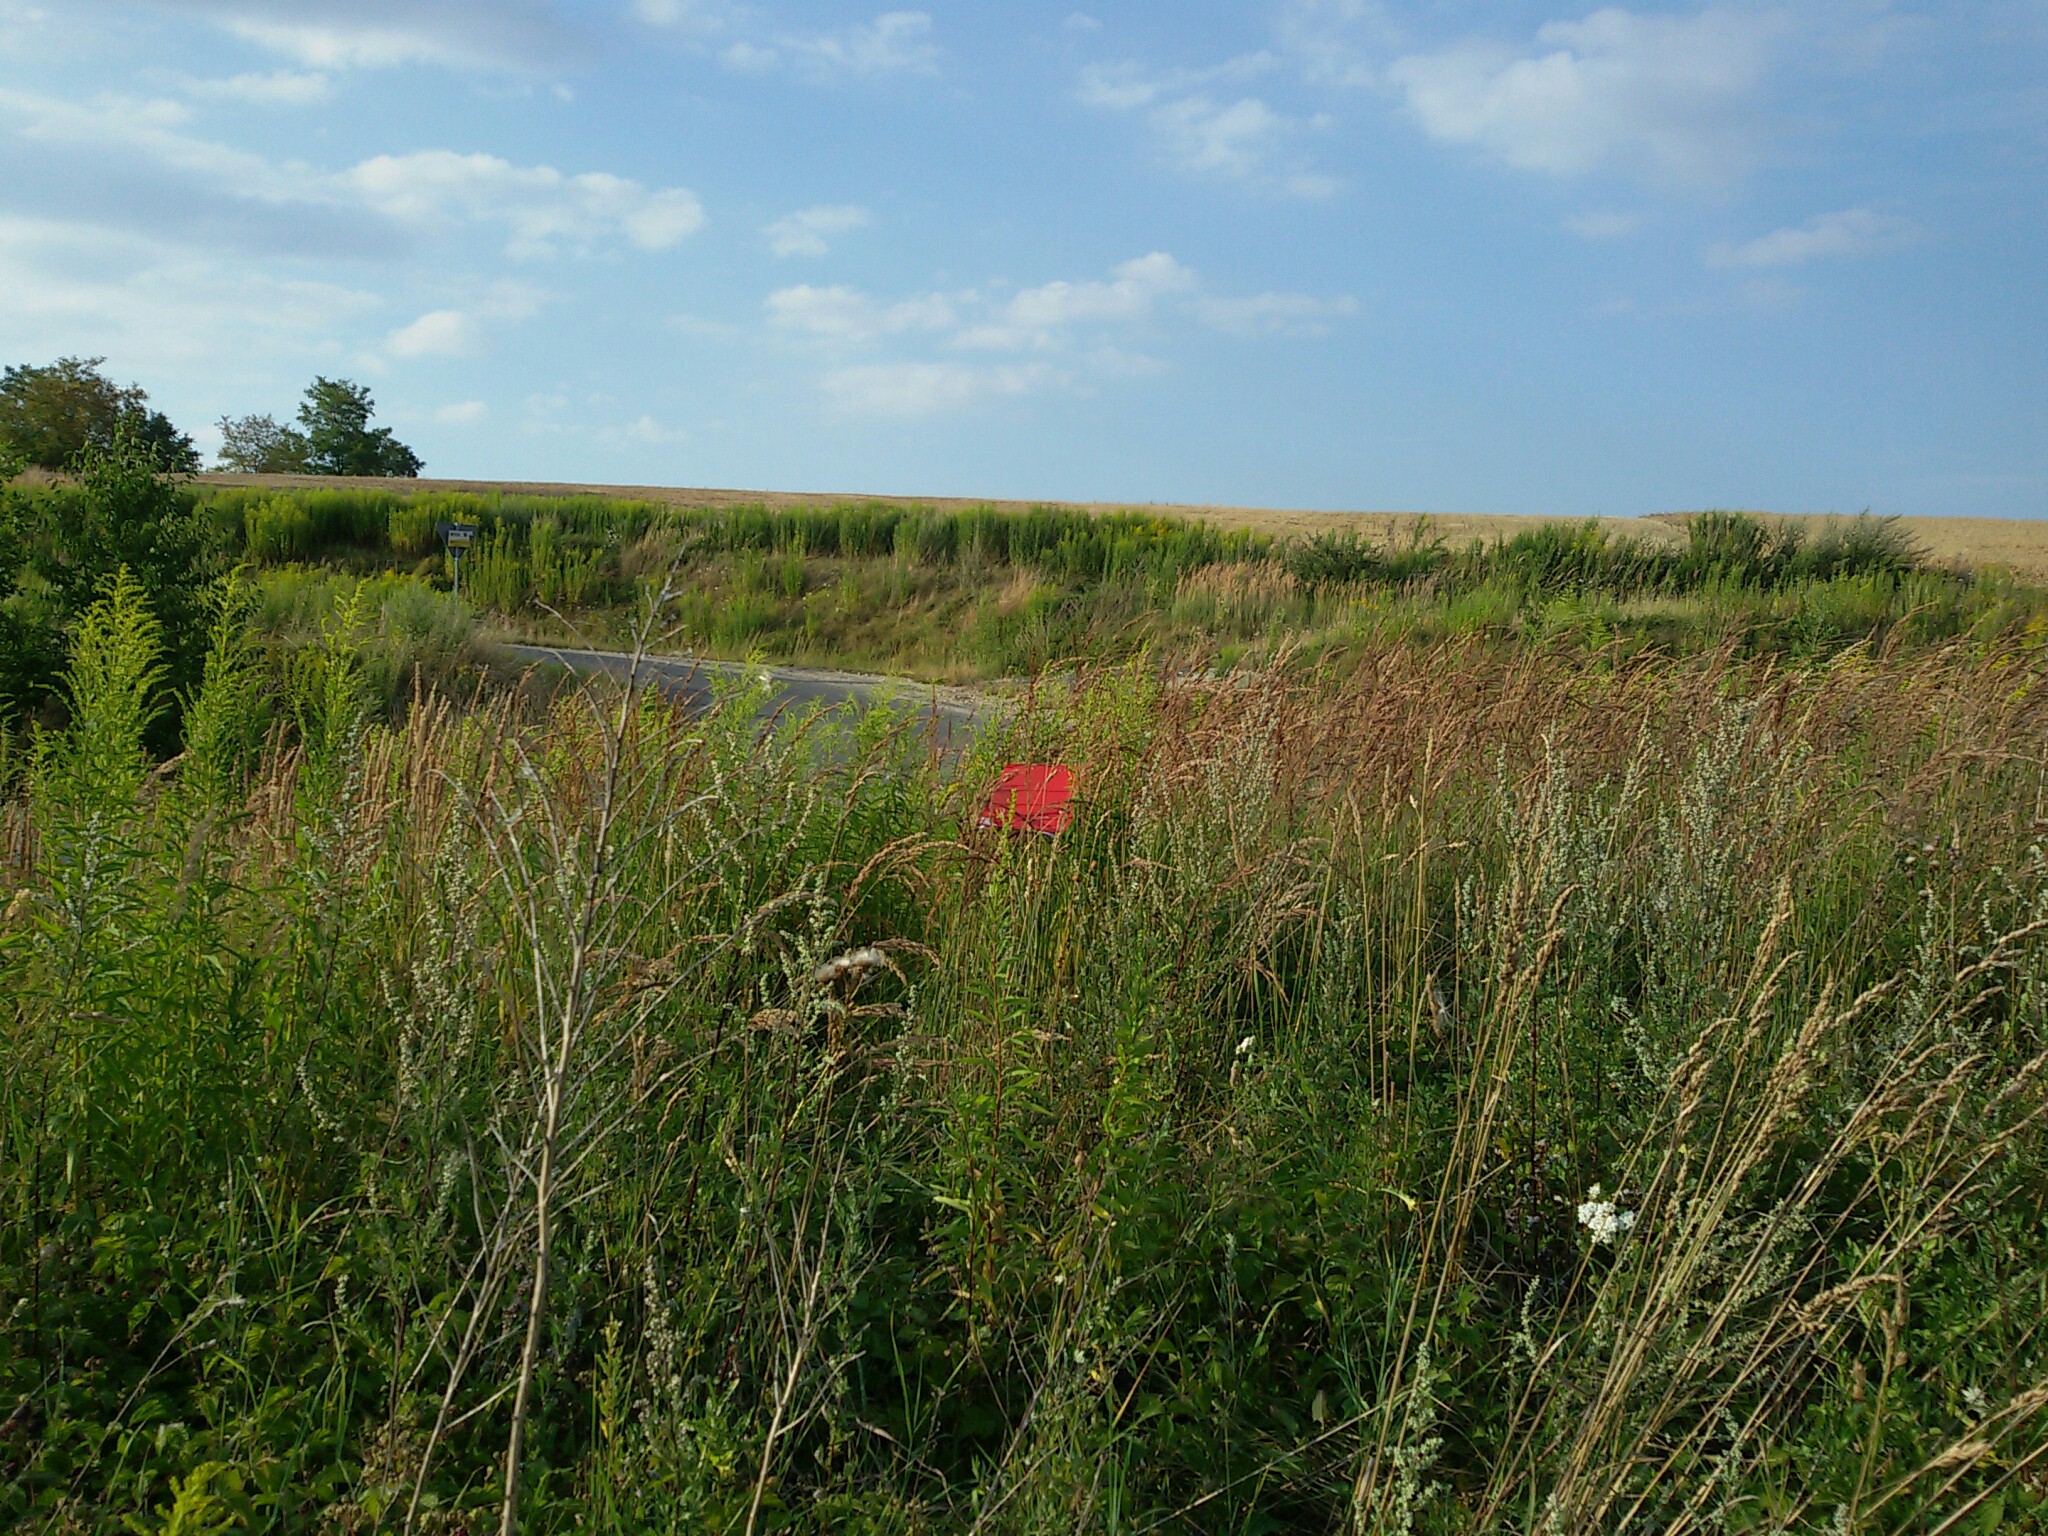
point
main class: Grassland
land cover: Spontaneously vegetated surfaces
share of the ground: > 75 %
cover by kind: herbaceous plants 100 %
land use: Semi-natural and natural areas not in use
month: August
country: PL
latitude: 51.1946
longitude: 15.7145
